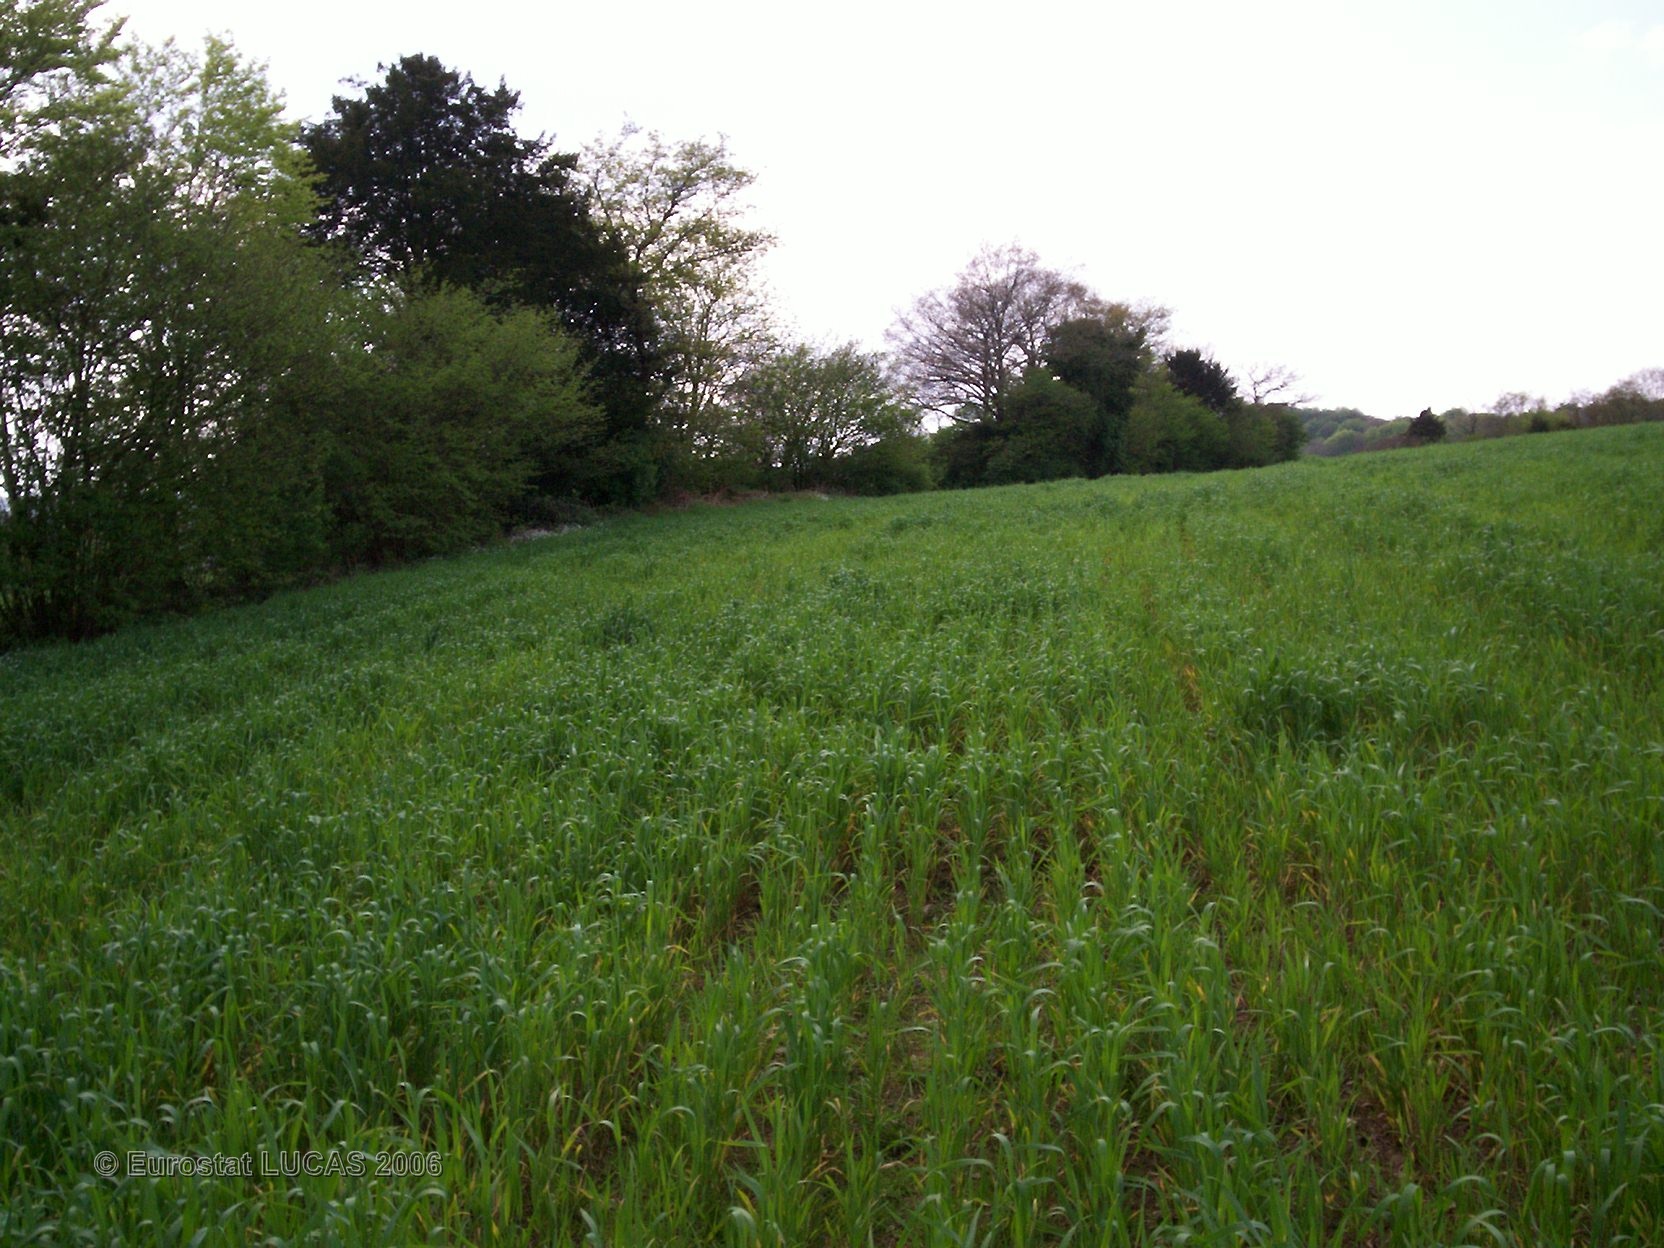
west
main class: Cropland
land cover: Barley
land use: Agriculture (excluding fallow land and kitchen gardens)
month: May
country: FR
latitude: 48.3909
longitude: -3.6537
